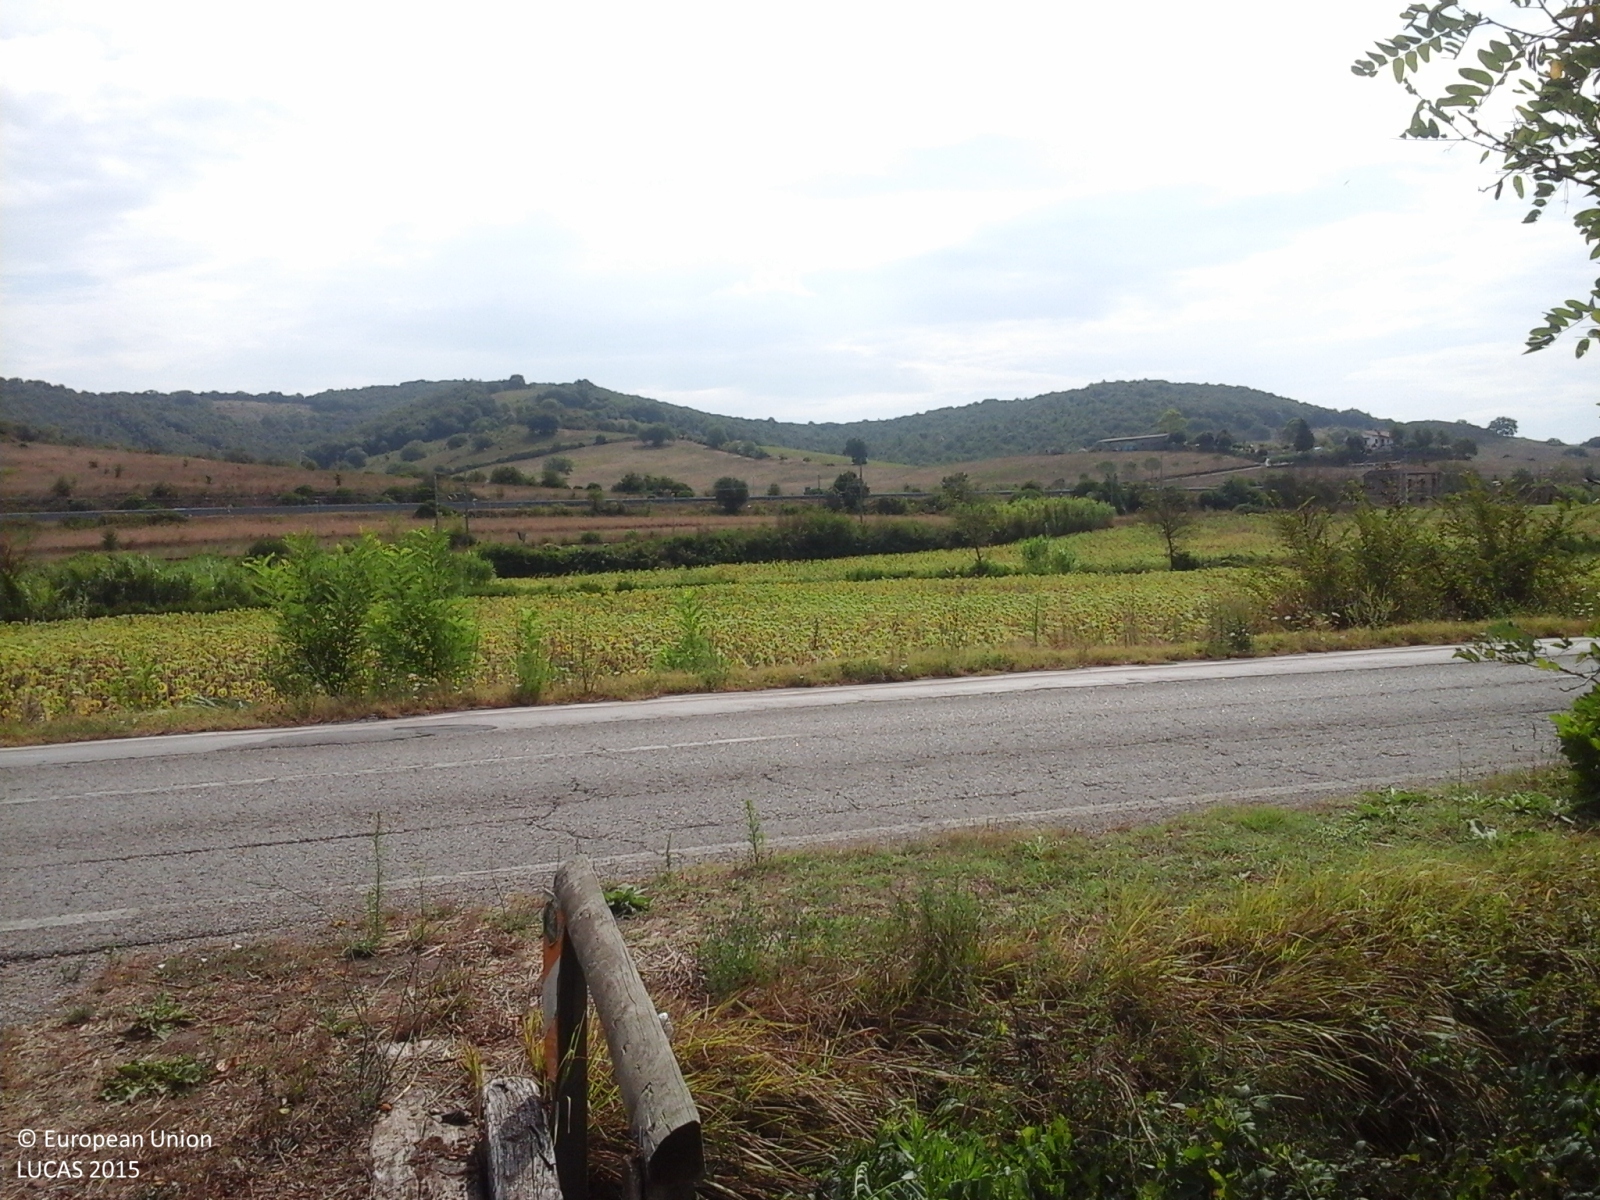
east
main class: Cropland
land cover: Olive groves
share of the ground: 50 - 75 %
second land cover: Grassland without tree/shrub cover
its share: 10 - 25 %
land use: Agriculture (excluding fallow land and kitchen gardens)
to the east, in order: Olive groves; Grassland without tree/shrub cover; Vineyards; Olive groves; Grassland without tree/shrub cover; Grass margins; Abandoned hedges; Ditches and canals; Grass margins; Paved roads, cycling and walking lanes; Grass margins; Sunflower; Grass margins; Ditches and canals; Grass margins; Sunflower; Abandoned hedges; Railways; Grassland without tree/shrub cover
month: August
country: IT
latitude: 42.9386
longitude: 10.9406
